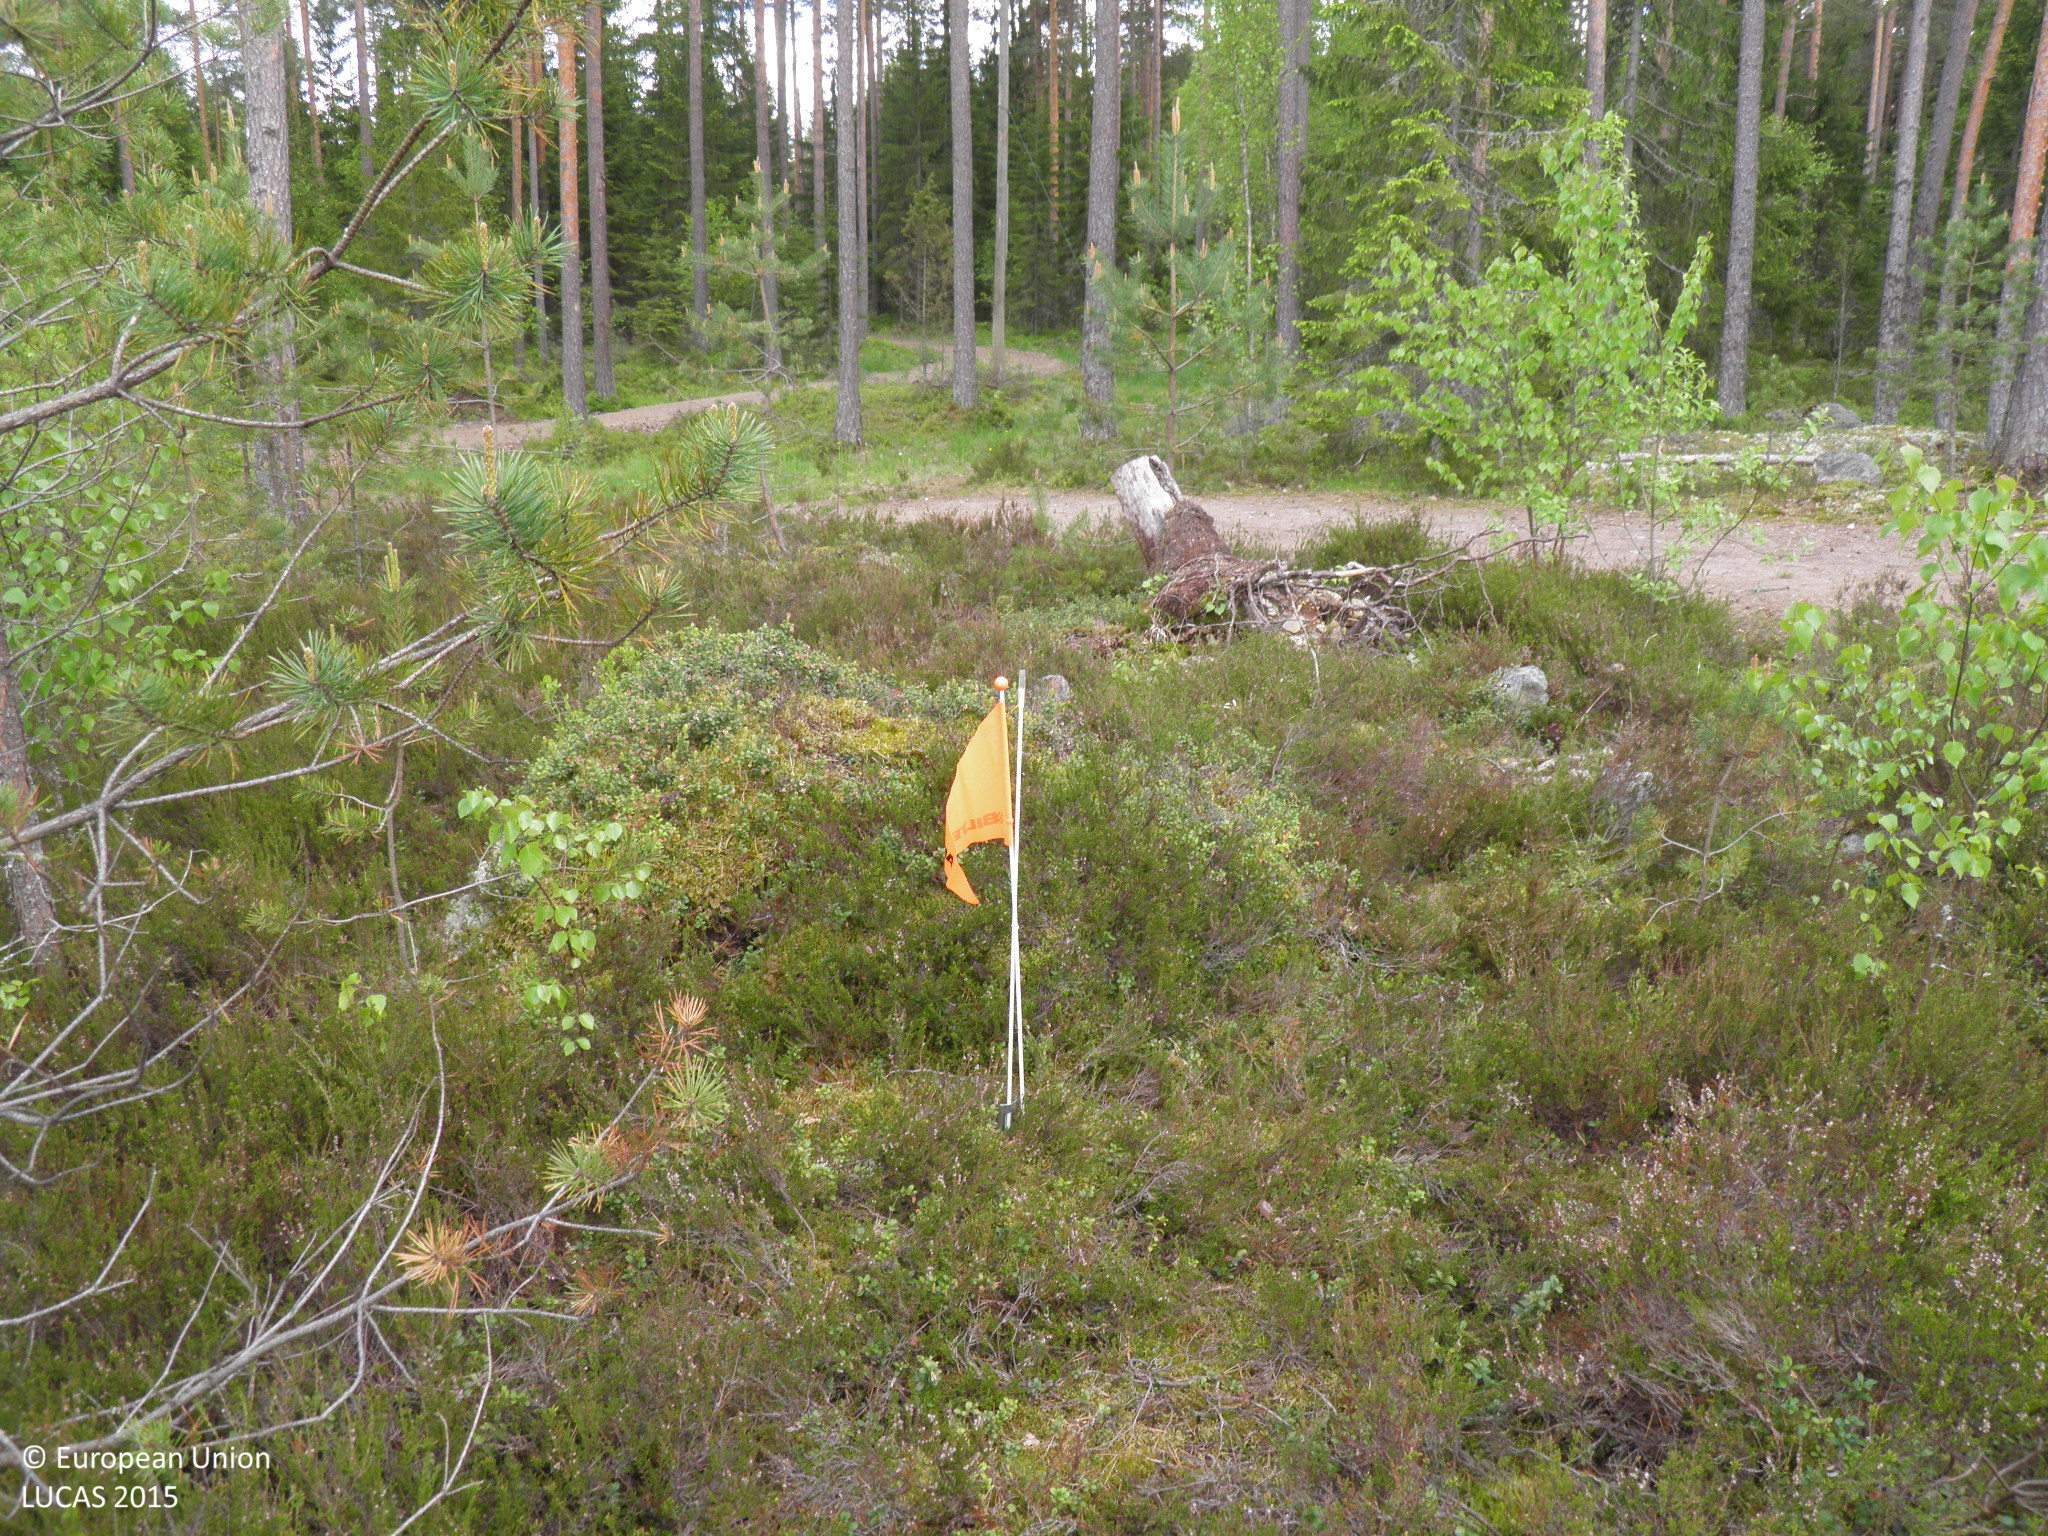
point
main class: Woodland
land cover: Pine dominated coniferous woodland
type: boreal forest
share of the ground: > 75 %
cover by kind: coniferous forest trees 85 %, shrubs 10 %, broadleaved forest trees 5 %
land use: Forestry
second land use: Sport
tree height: > 5 m
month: June
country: FI
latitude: 60.5850
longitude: 22.7597
